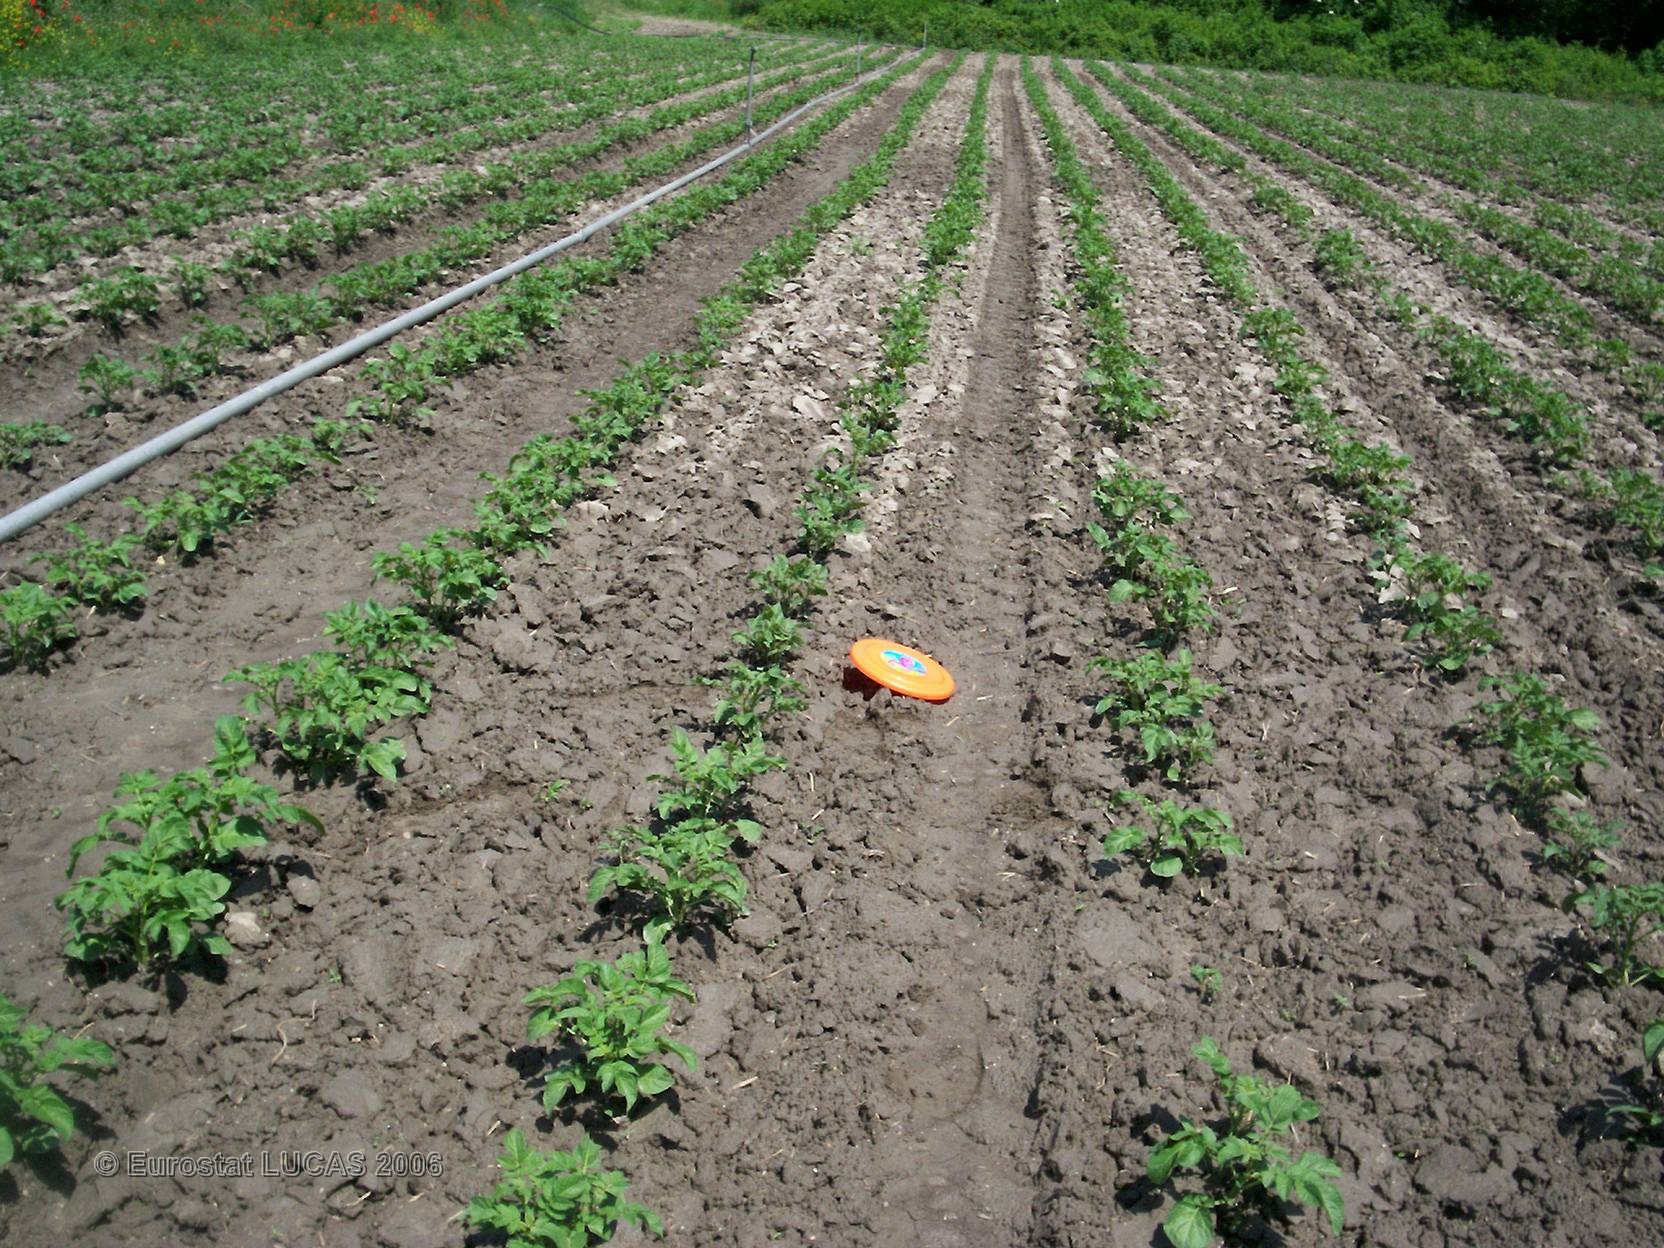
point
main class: Cropland
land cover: Potatoes
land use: Agriculture (excluding fallow land and kitchen gardens)
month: May
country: FR
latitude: 44.8733
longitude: 4.8541
